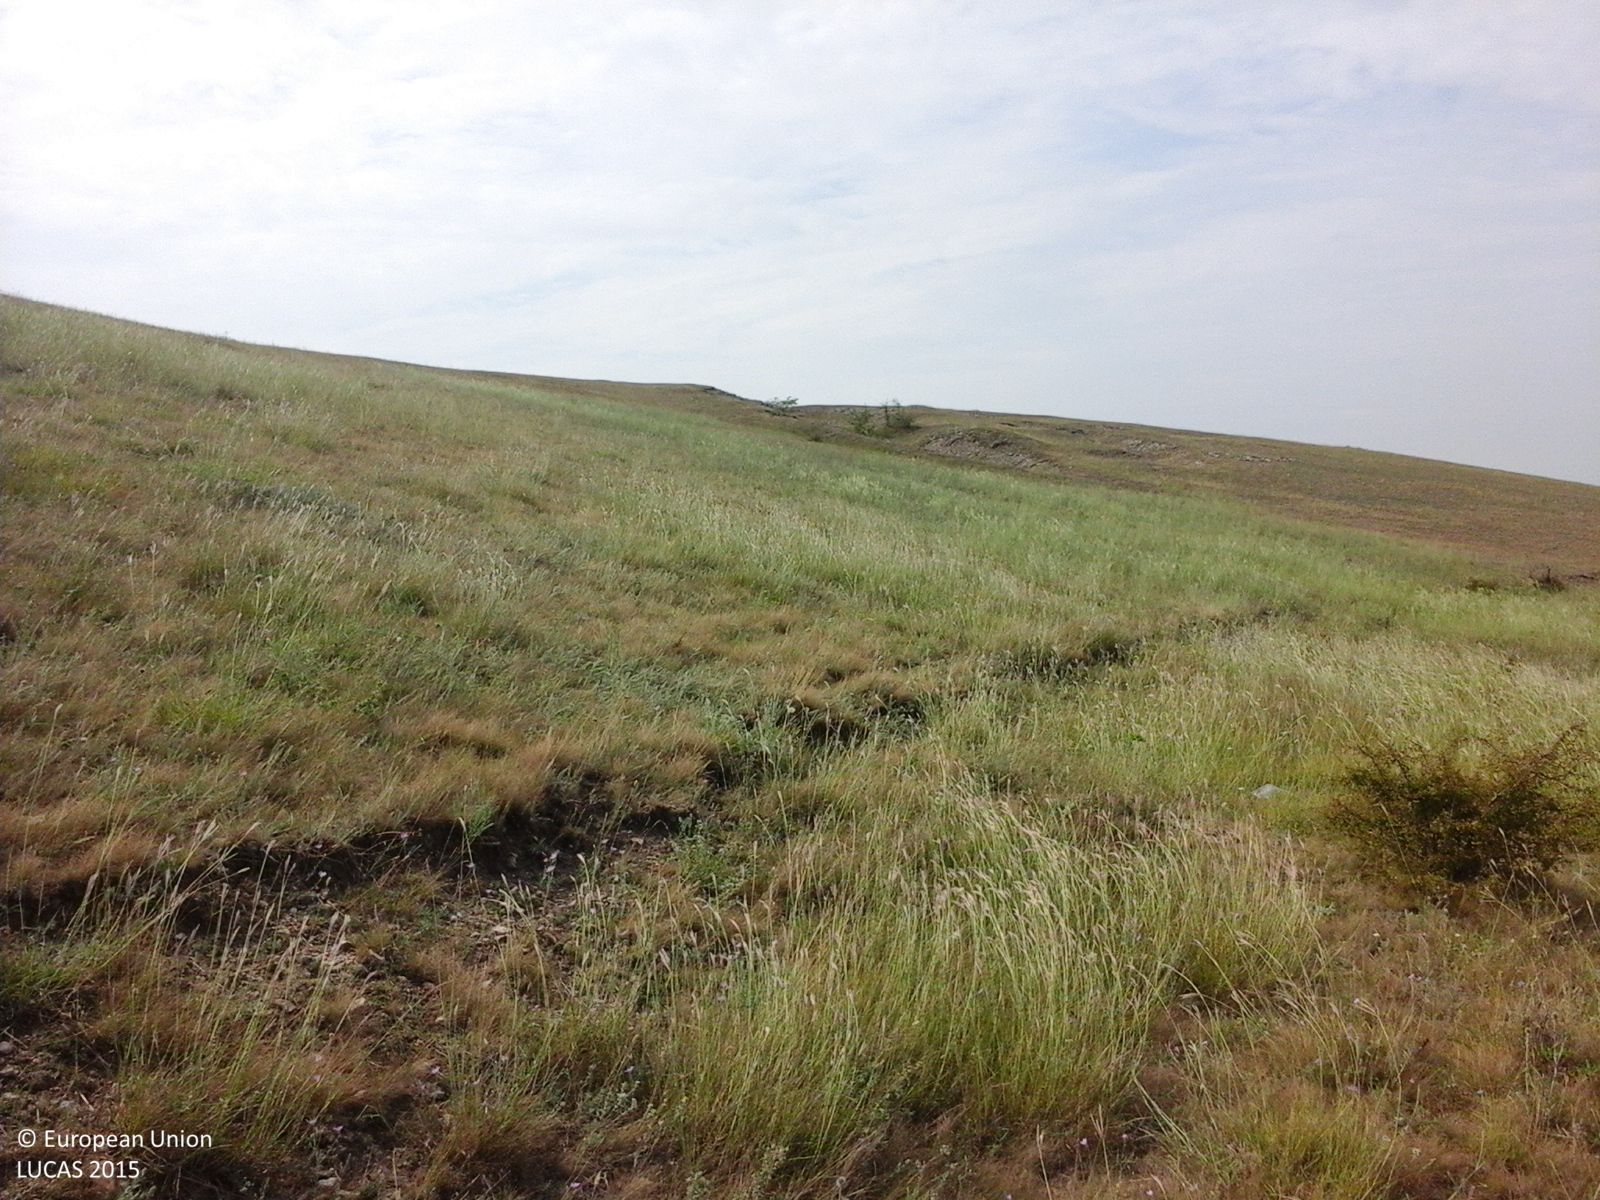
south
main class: Grassland
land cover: Grassland with sparse tree/shrub cover
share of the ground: > 75 %
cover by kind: herbaceous plants 85 %, shrubs 10 %, broadleaved forest trees 5 %
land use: Agriculture (excluding fallow land and kitchen gardens)
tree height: < 5 m
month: August
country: RO
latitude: 45.0614
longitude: 28.9528
